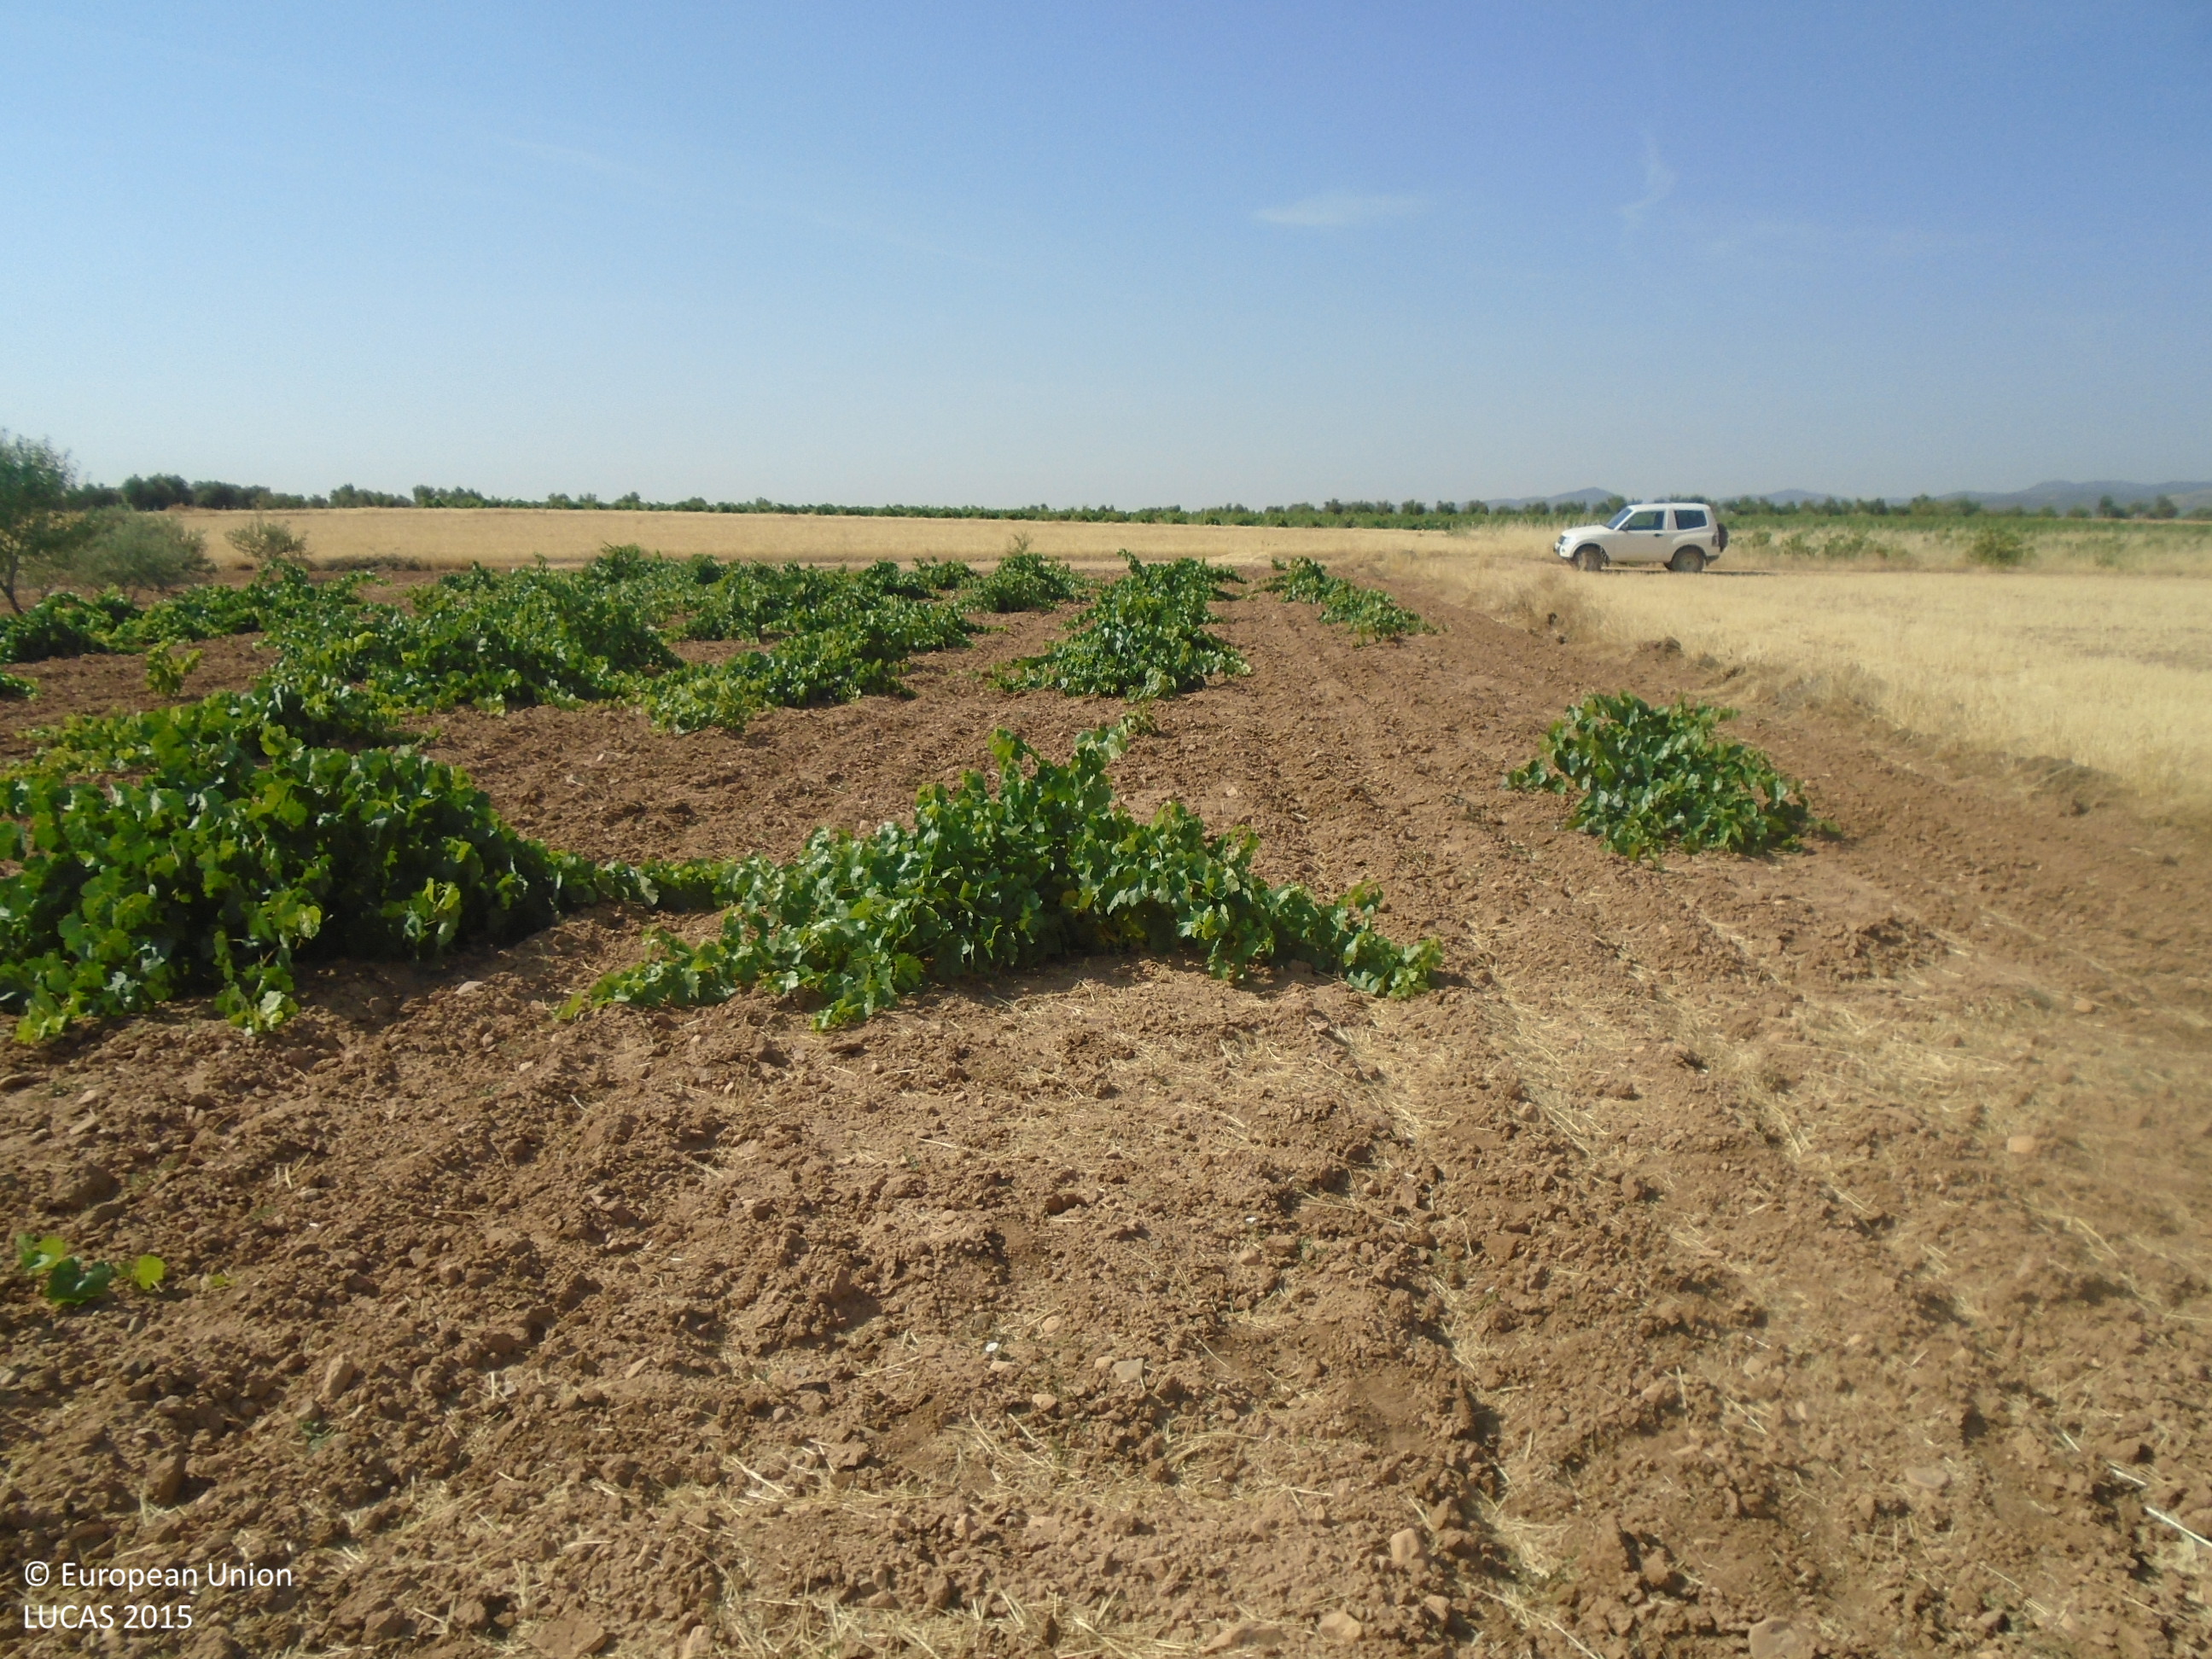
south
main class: Cropland
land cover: Vineyards
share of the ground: 10 - 25 %
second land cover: Other bare soil
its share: > 75 %
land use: Agriculture (excluding fallow land and kitchen gardens)
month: July
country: ES
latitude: 39.4347
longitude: -3.5340
